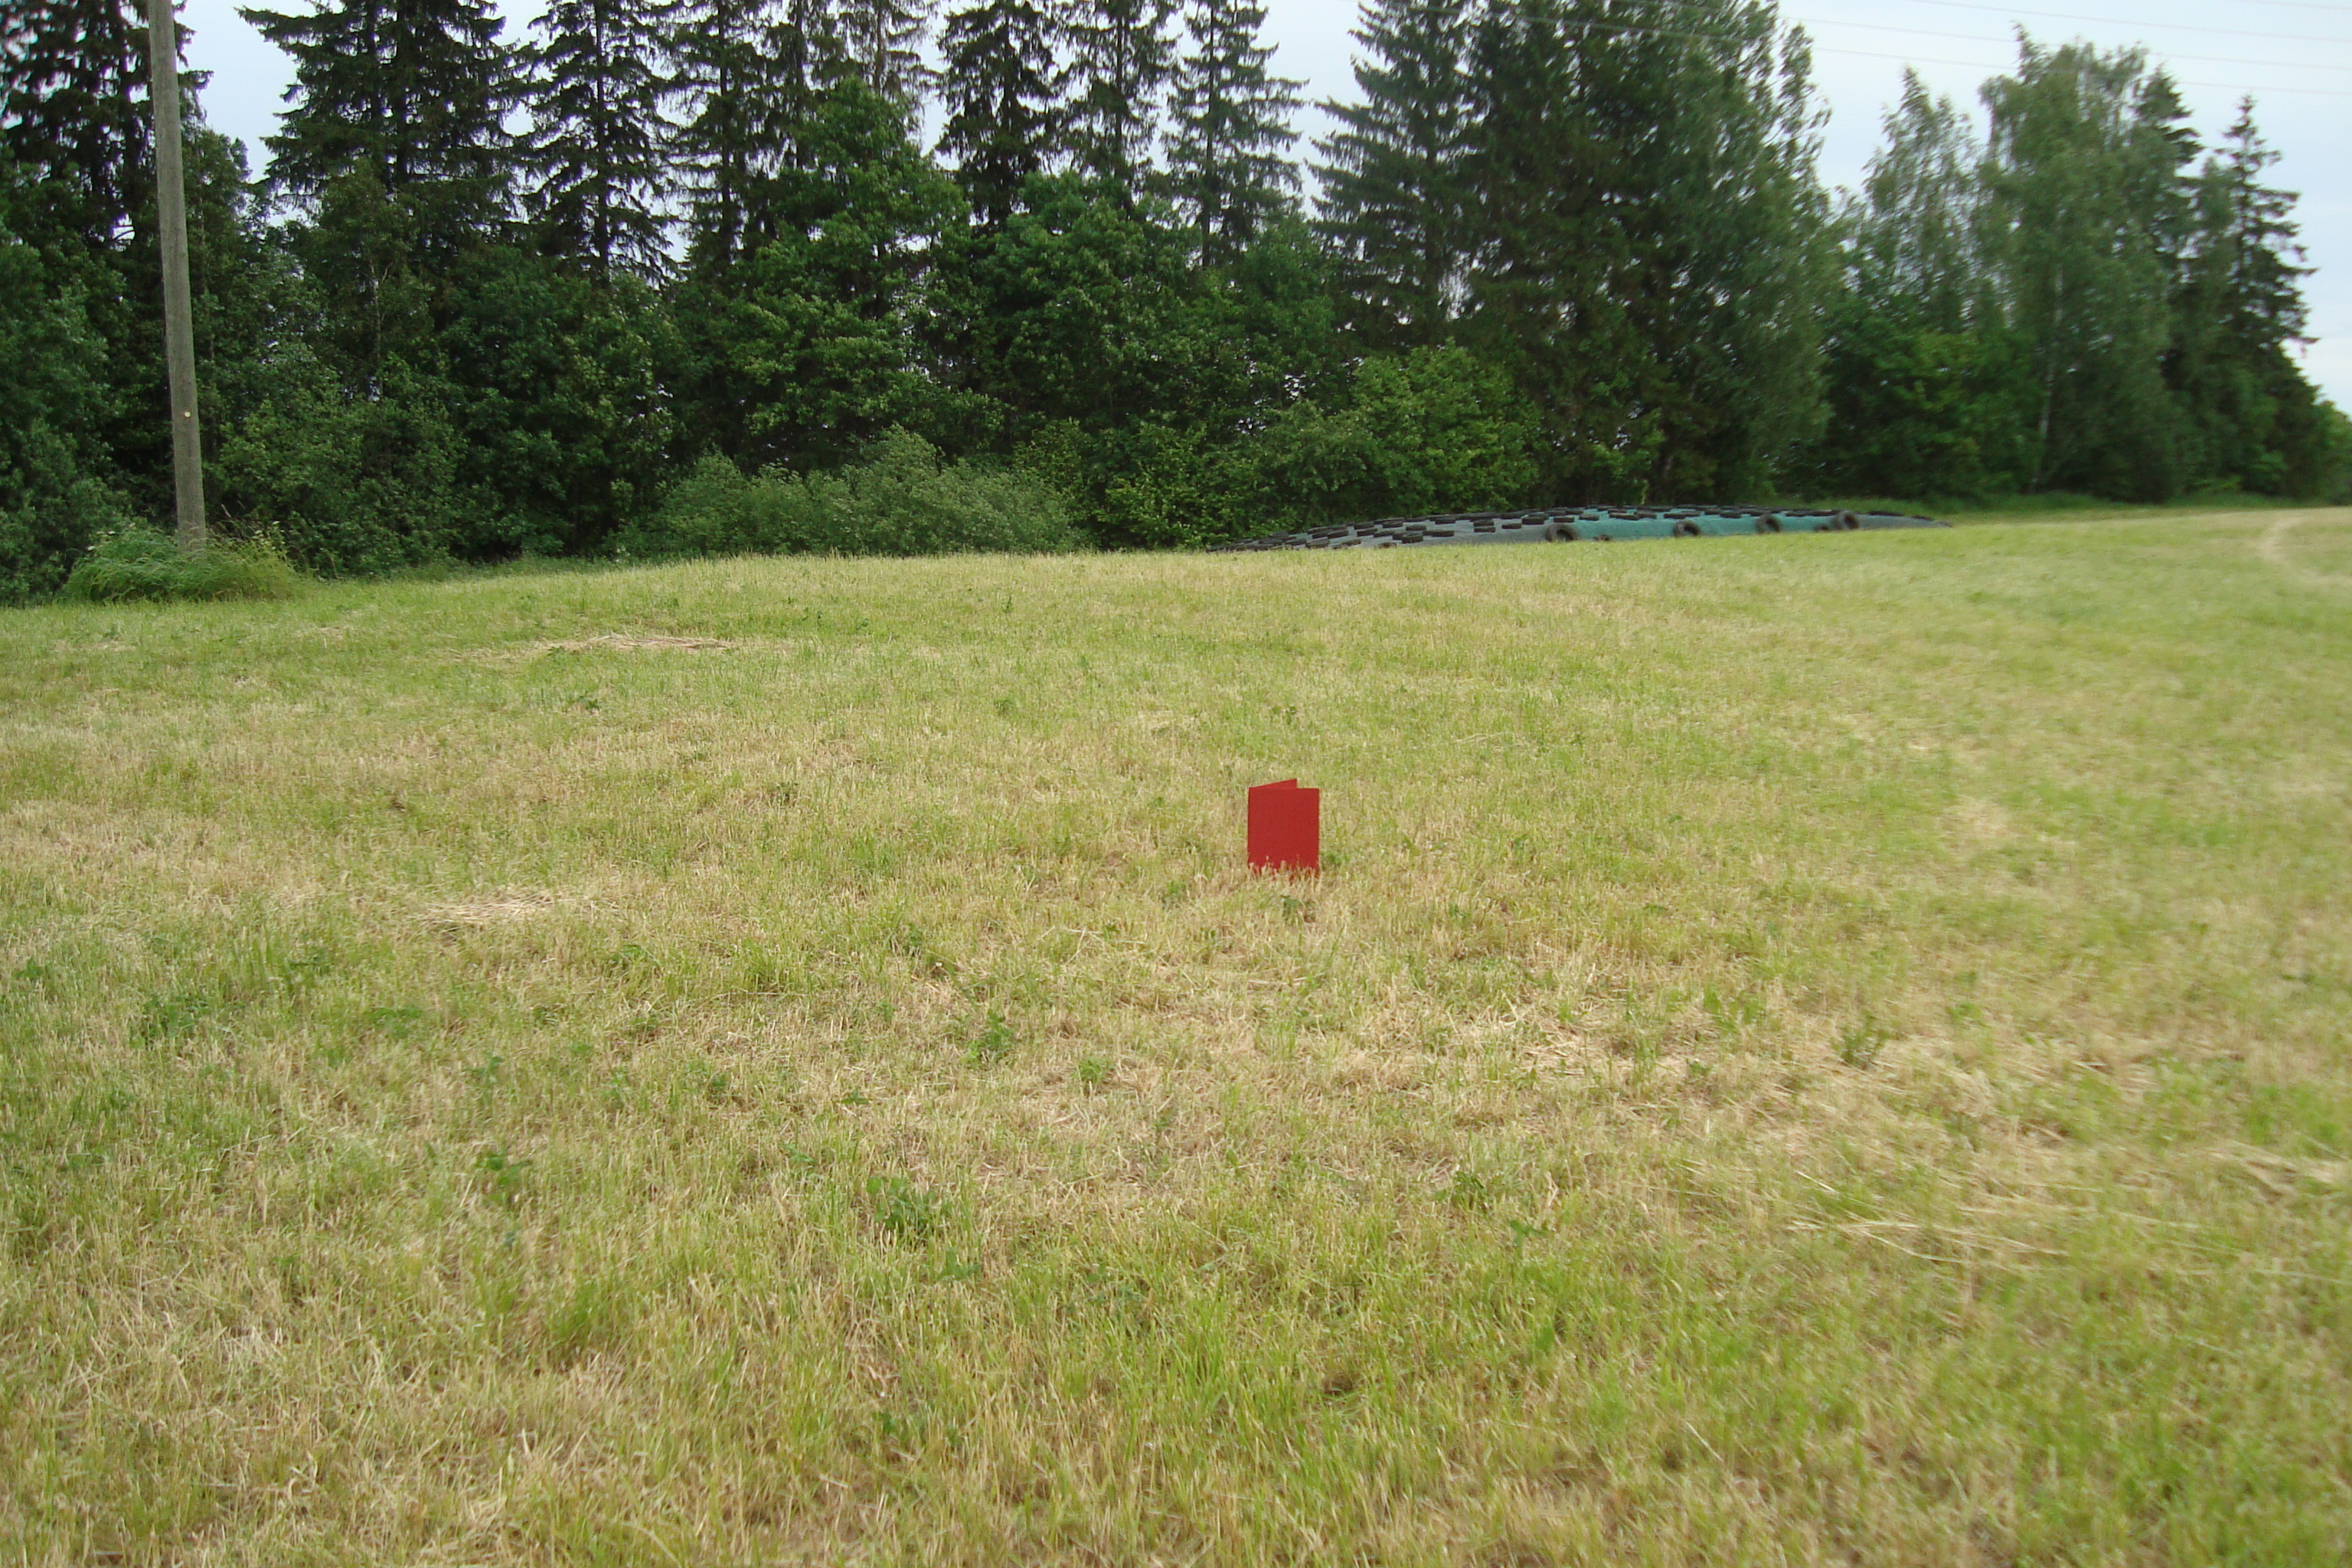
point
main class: Grassland
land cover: Grassland without tree/shrub cover
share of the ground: > 75 %
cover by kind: herbaceous plants 100 %
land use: Agriculture (excluding fallow land and kitchen gardens)
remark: Harvested field
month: June
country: LV
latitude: 57.1823
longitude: 26.4040
